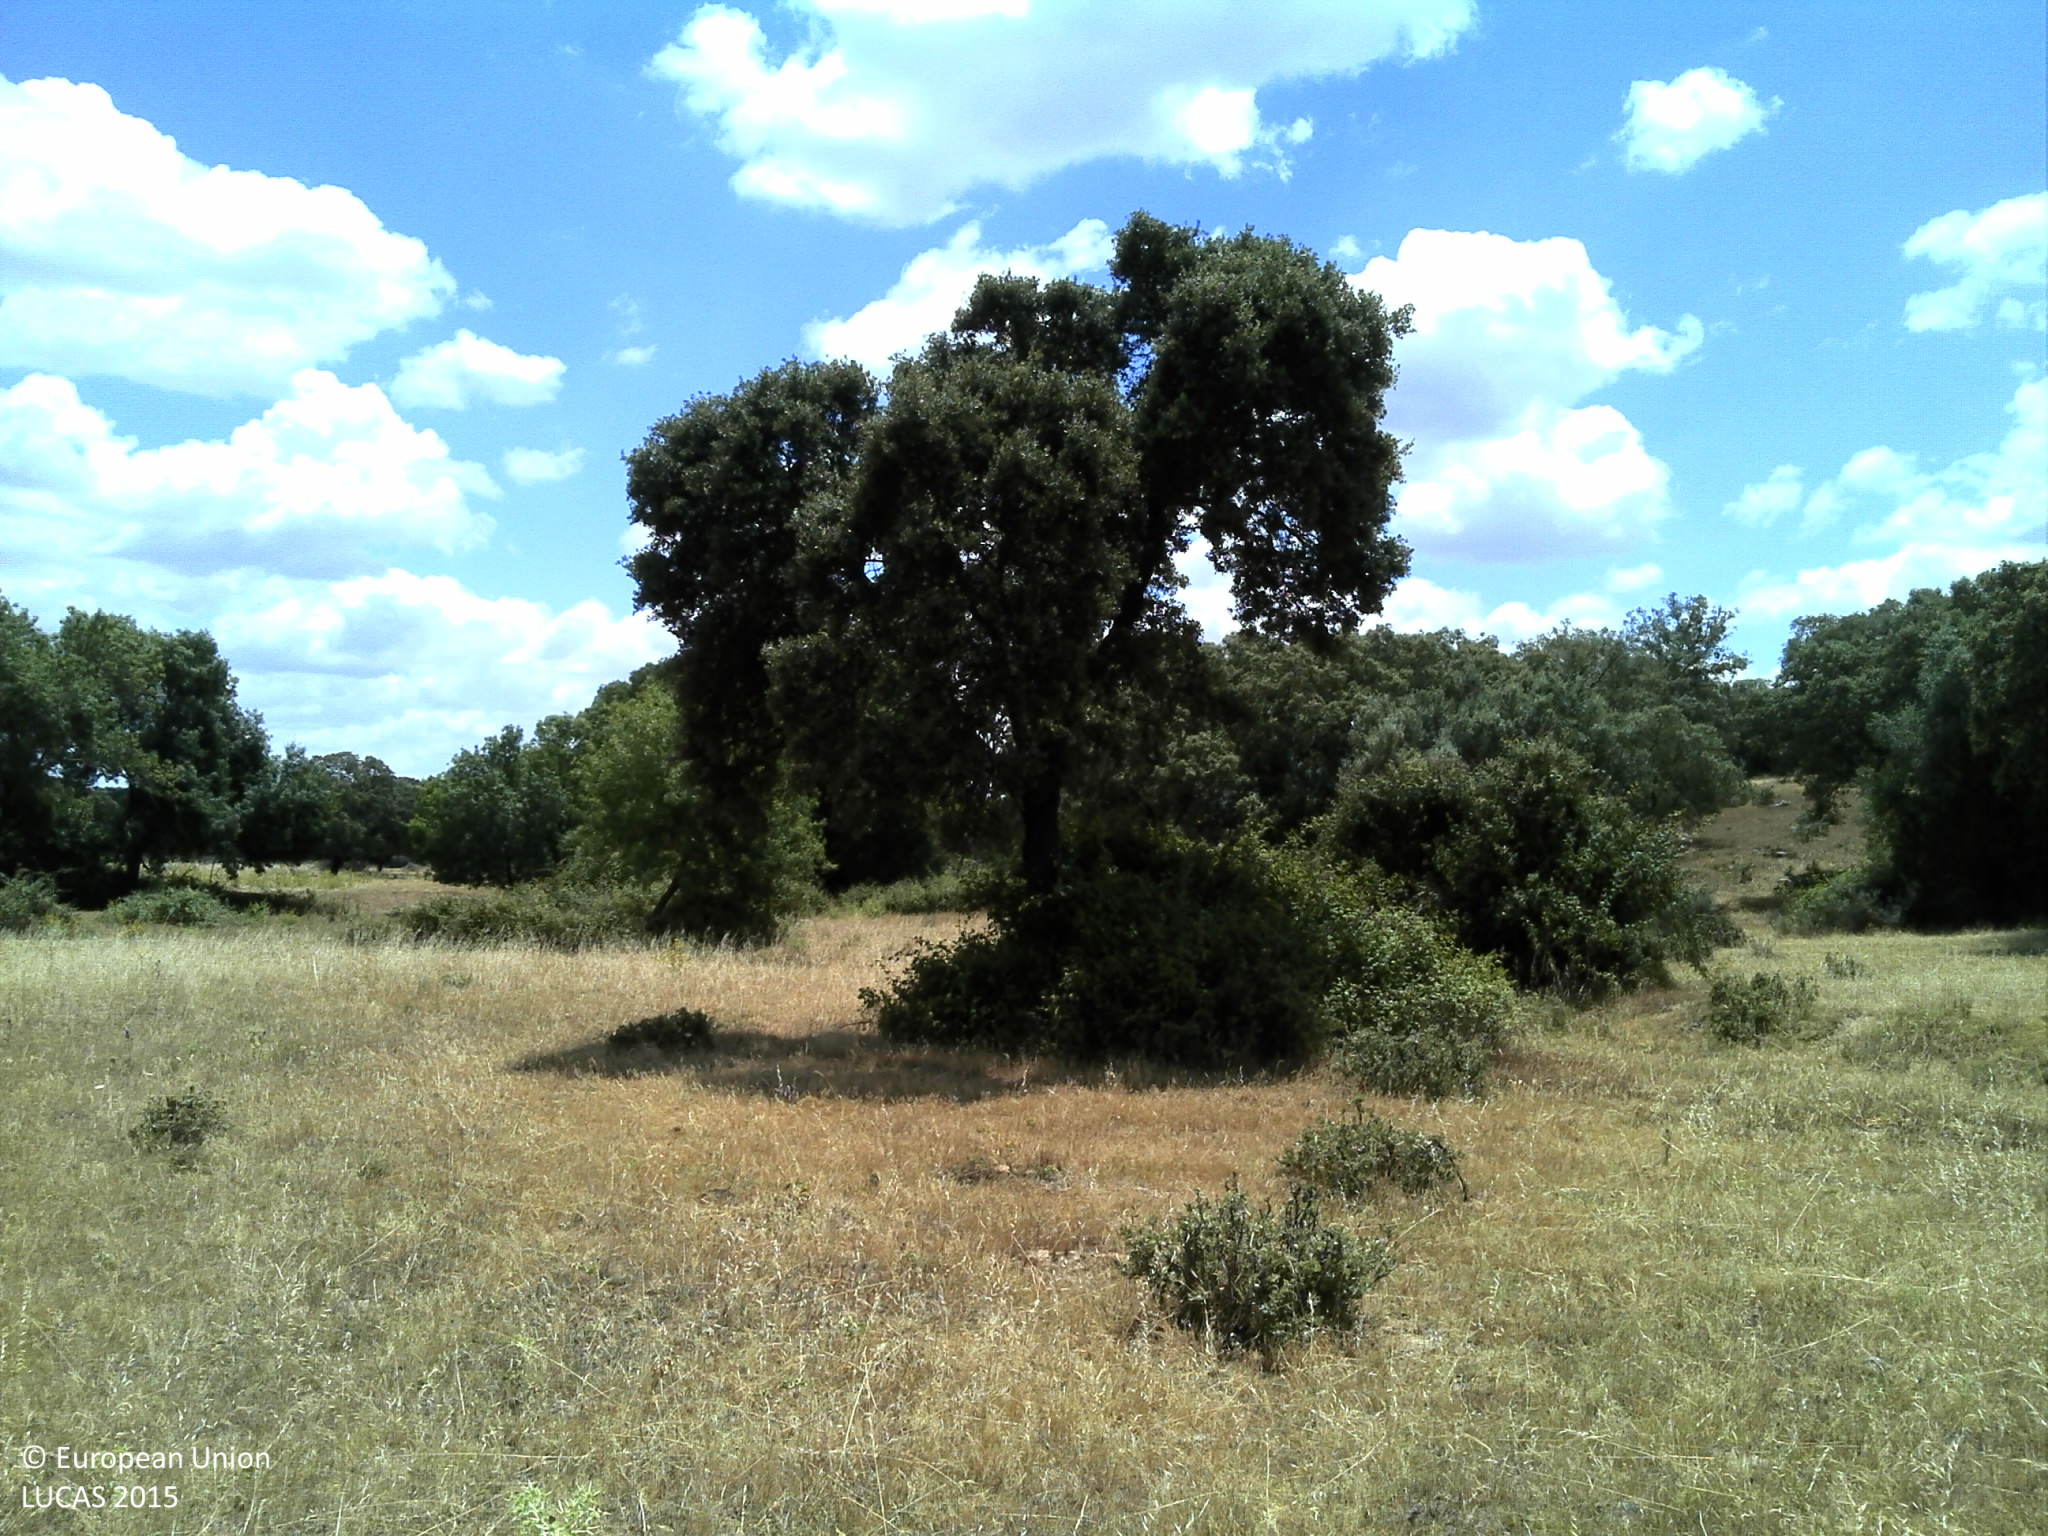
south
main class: Grassland
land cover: Grassland with sparse tree/shrub cover
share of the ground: 25 - 50 %
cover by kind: unconsolidated bare surface 55 %, herbaceous plants 40 %, broadleaved forest trees 5 %
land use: Agriculture (excluding fallow land and kitchen gardens)
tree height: > 5 m
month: June
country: PT
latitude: 38.5113
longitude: -8.1056
